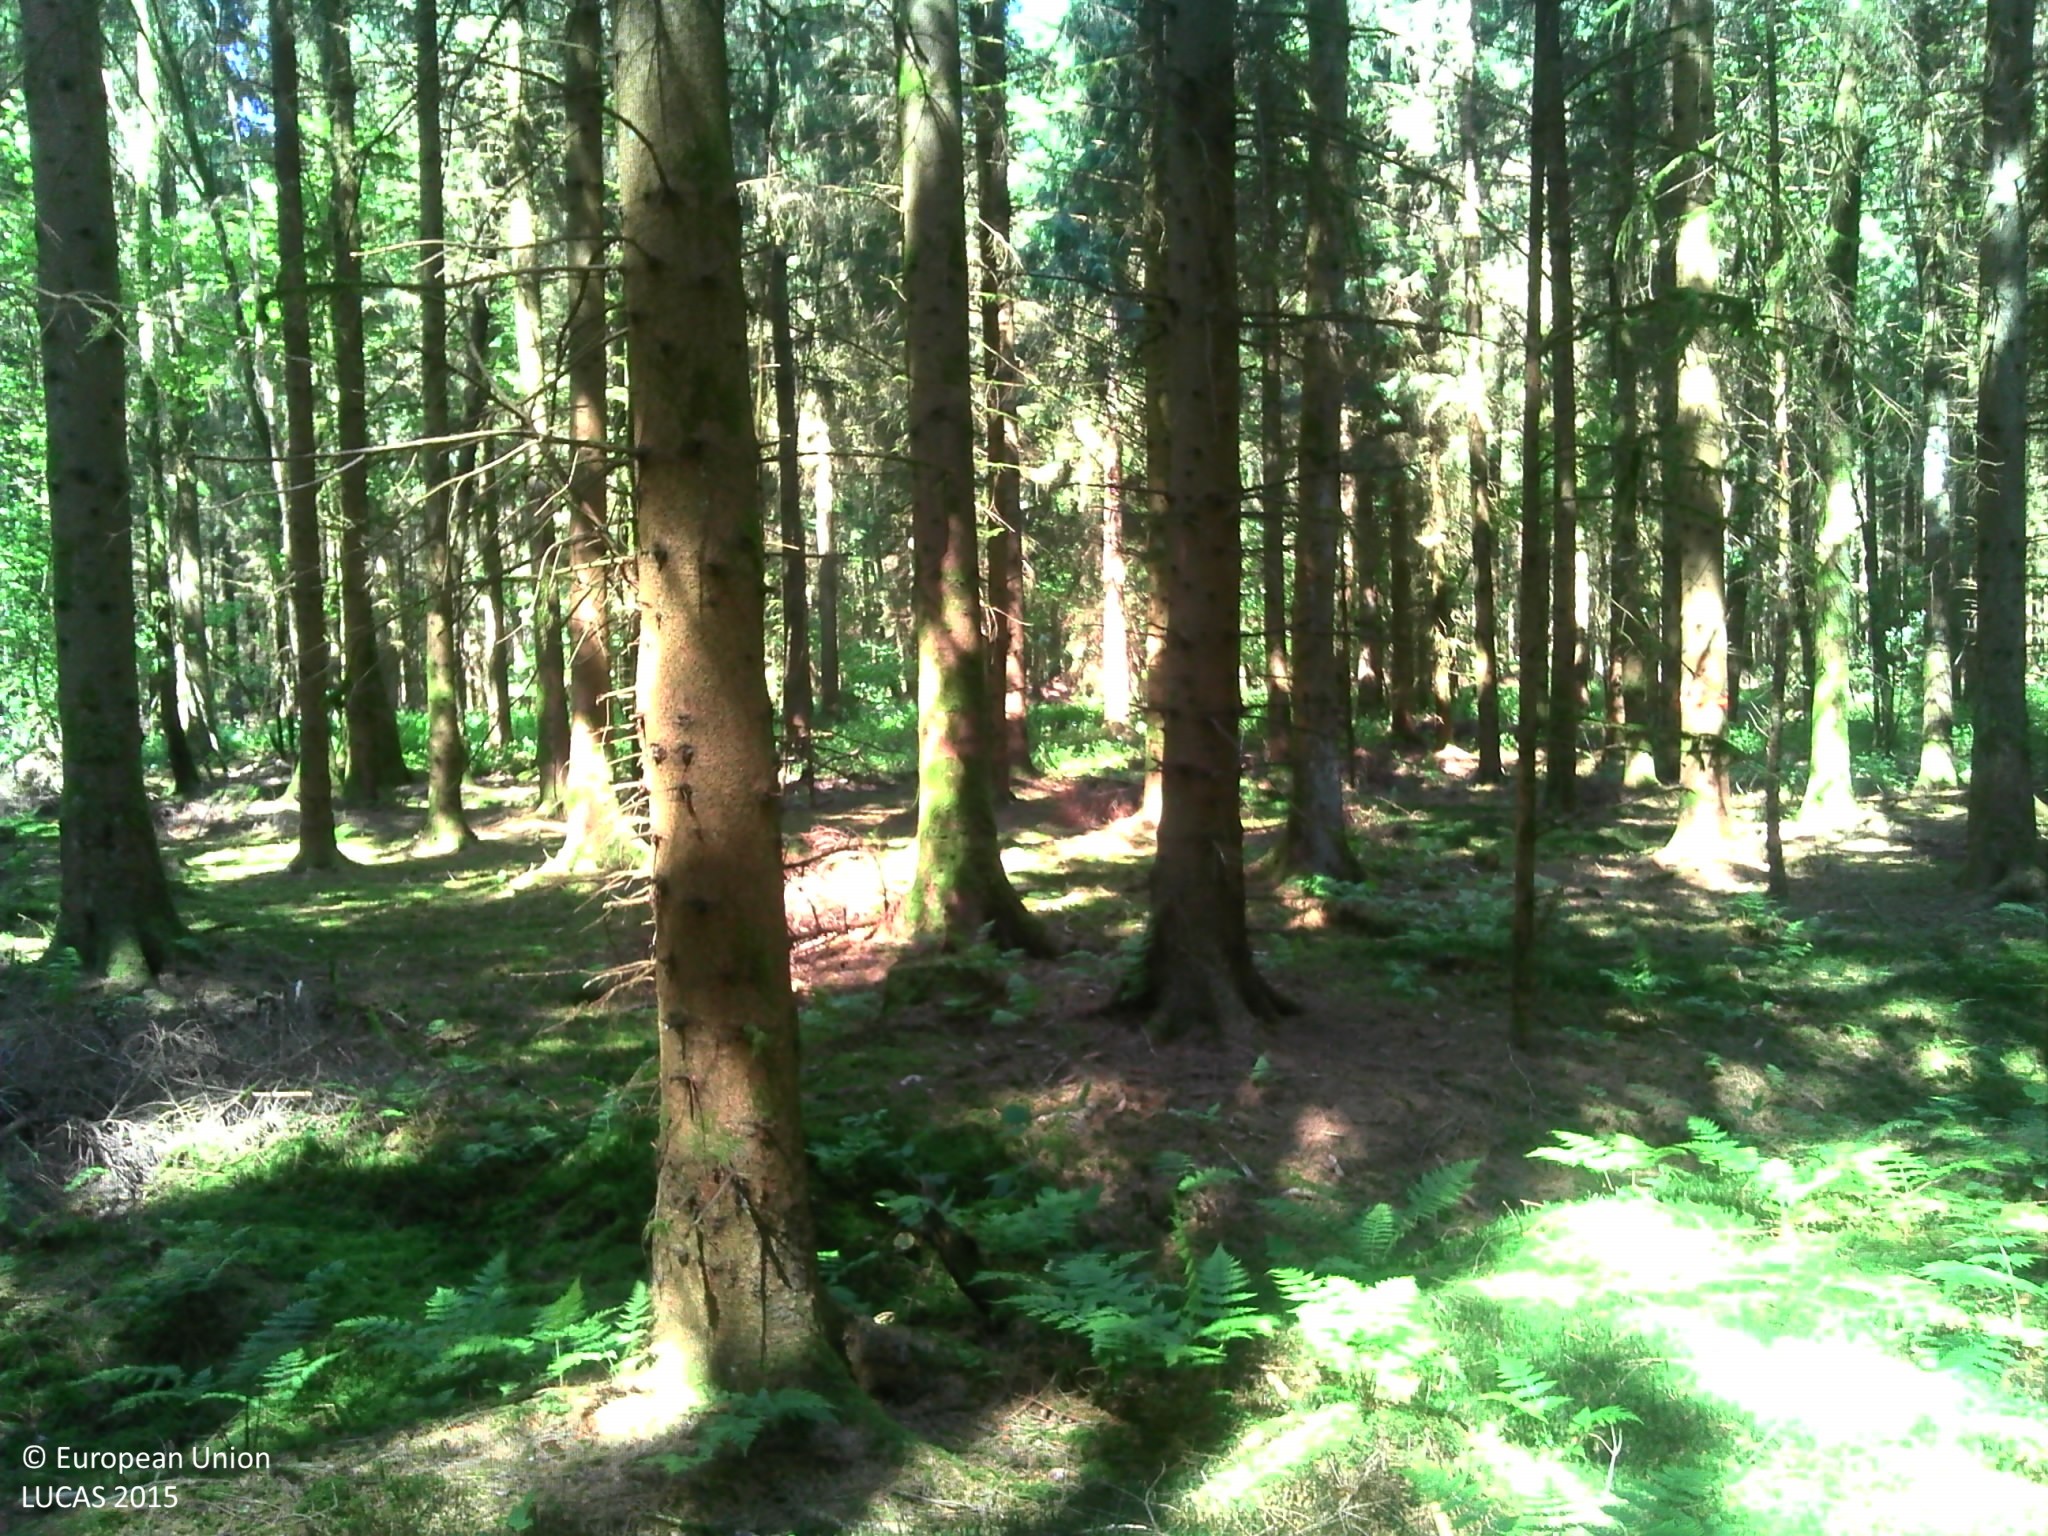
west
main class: Woodland
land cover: Spruce dominated coniferous woodland
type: exotic forest
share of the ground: > 75 %
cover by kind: coniferous forest trees 90 %, lichens and mosses 10 %
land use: Forestry
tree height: > 5 m
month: June
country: FR
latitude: 49.9636
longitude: 4.1818
